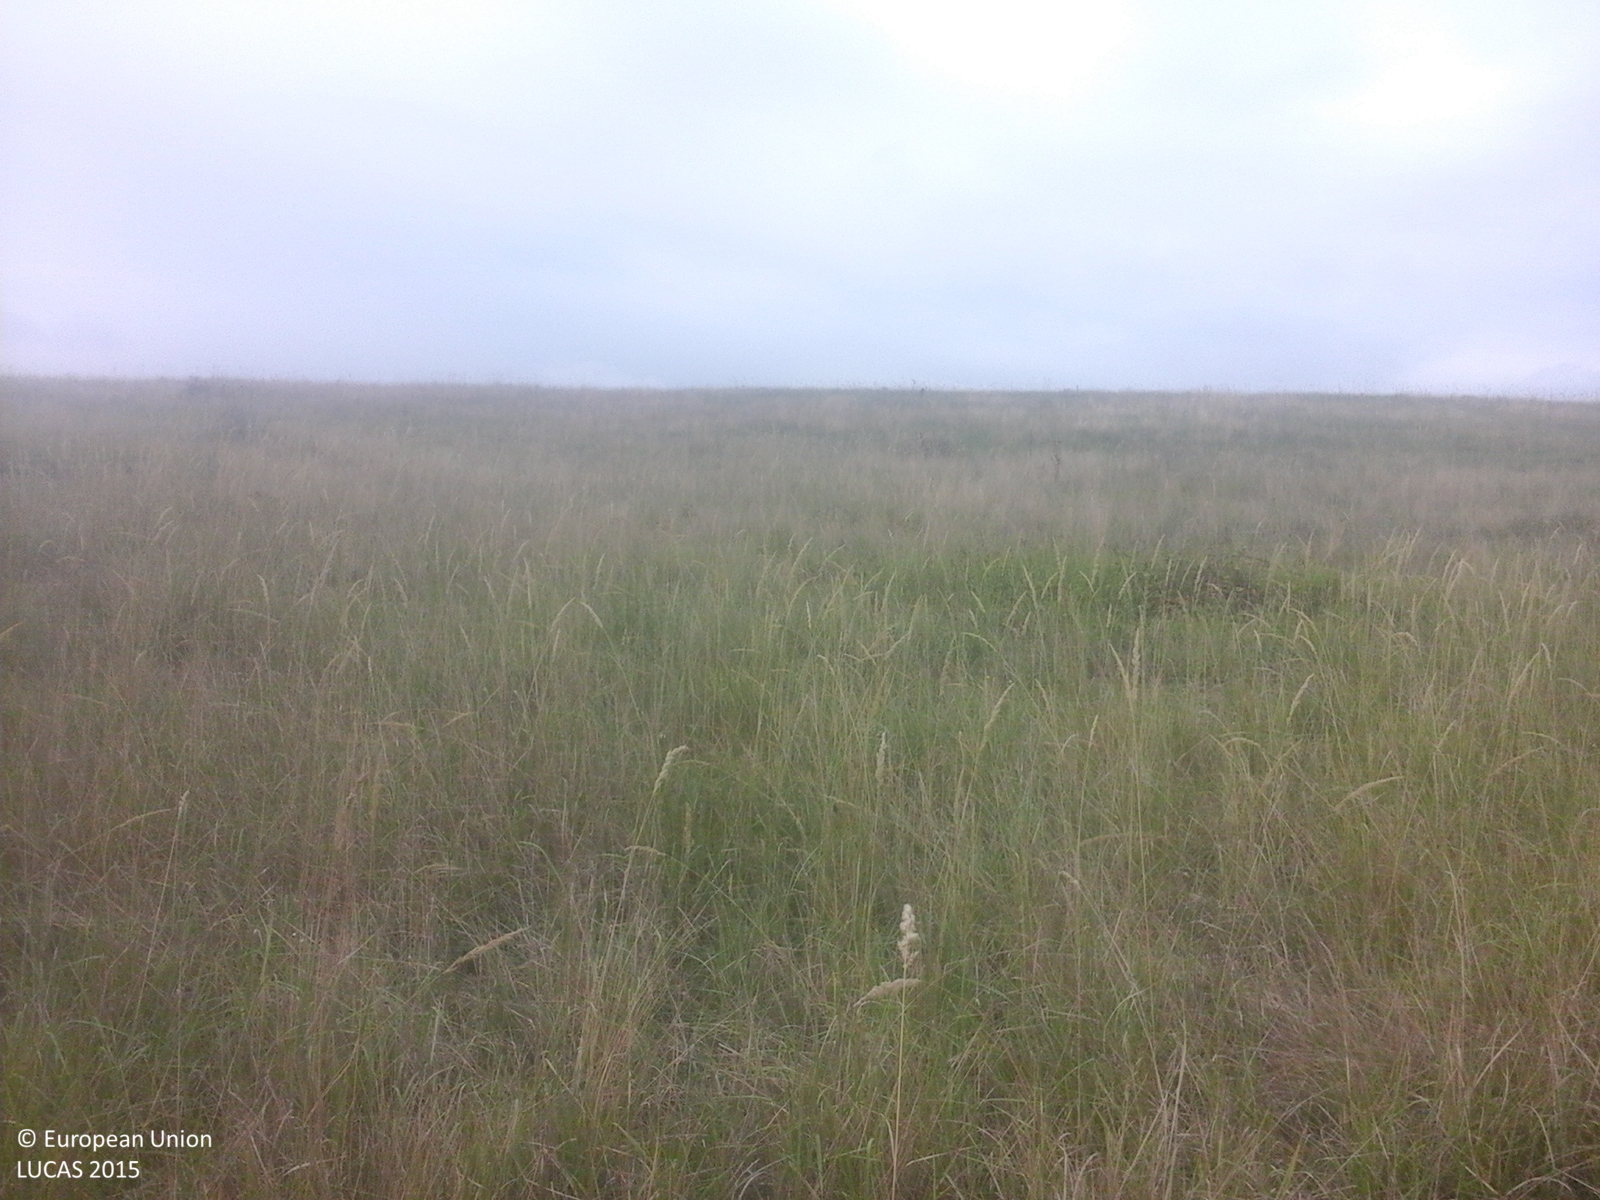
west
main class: Grassland
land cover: Grassland without tree/shrub cover
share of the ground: > 75 %
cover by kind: herbaceous plants 100 %
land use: Agriculture (excluding fallow land and kitchen gardens)
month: September
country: RO
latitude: 45.8811
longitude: 22.0894
